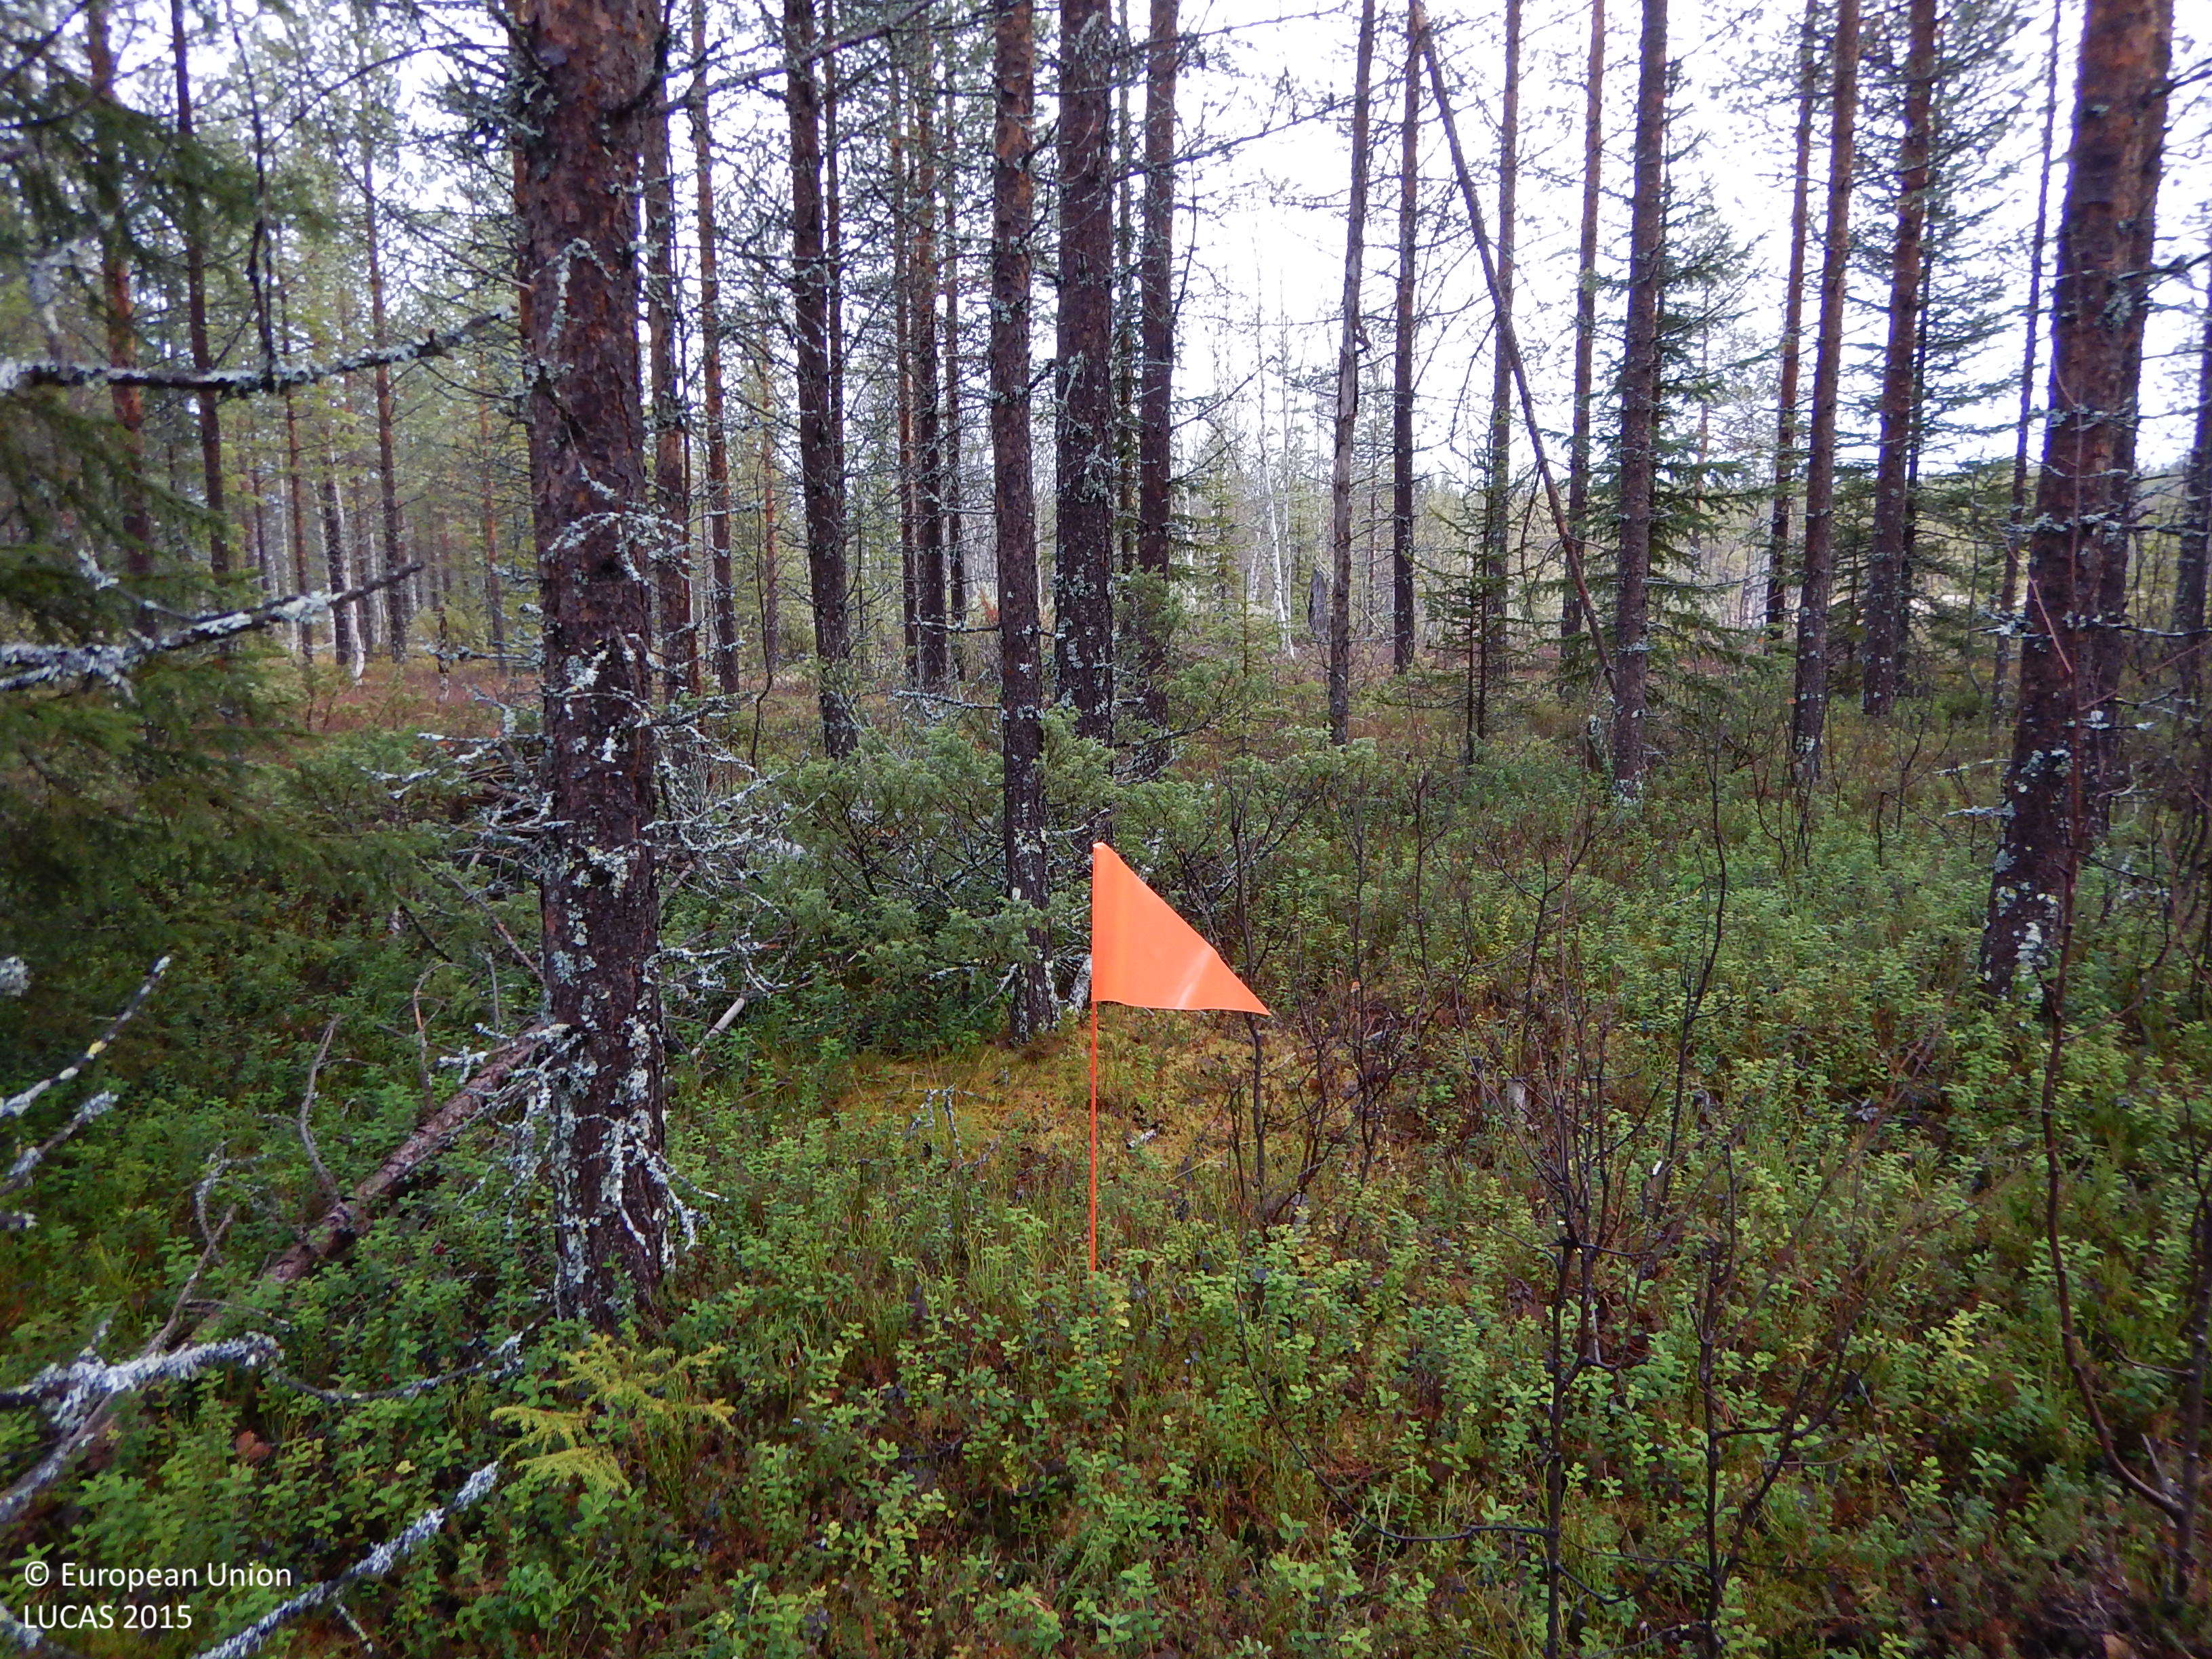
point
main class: Woodland
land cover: Pine dominated coniferous woodland
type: boreal forest
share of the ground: 50 - 75 %
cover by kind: coniferous forest trees 50 %, shrubs 25 %, lichens and mosses 15 %, broadleaved forest trees 5 %, herbaceous plants 5 %
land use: Forestry
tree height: > 5 m
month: November
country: SE
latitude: 65.2250
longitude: 20.3845
